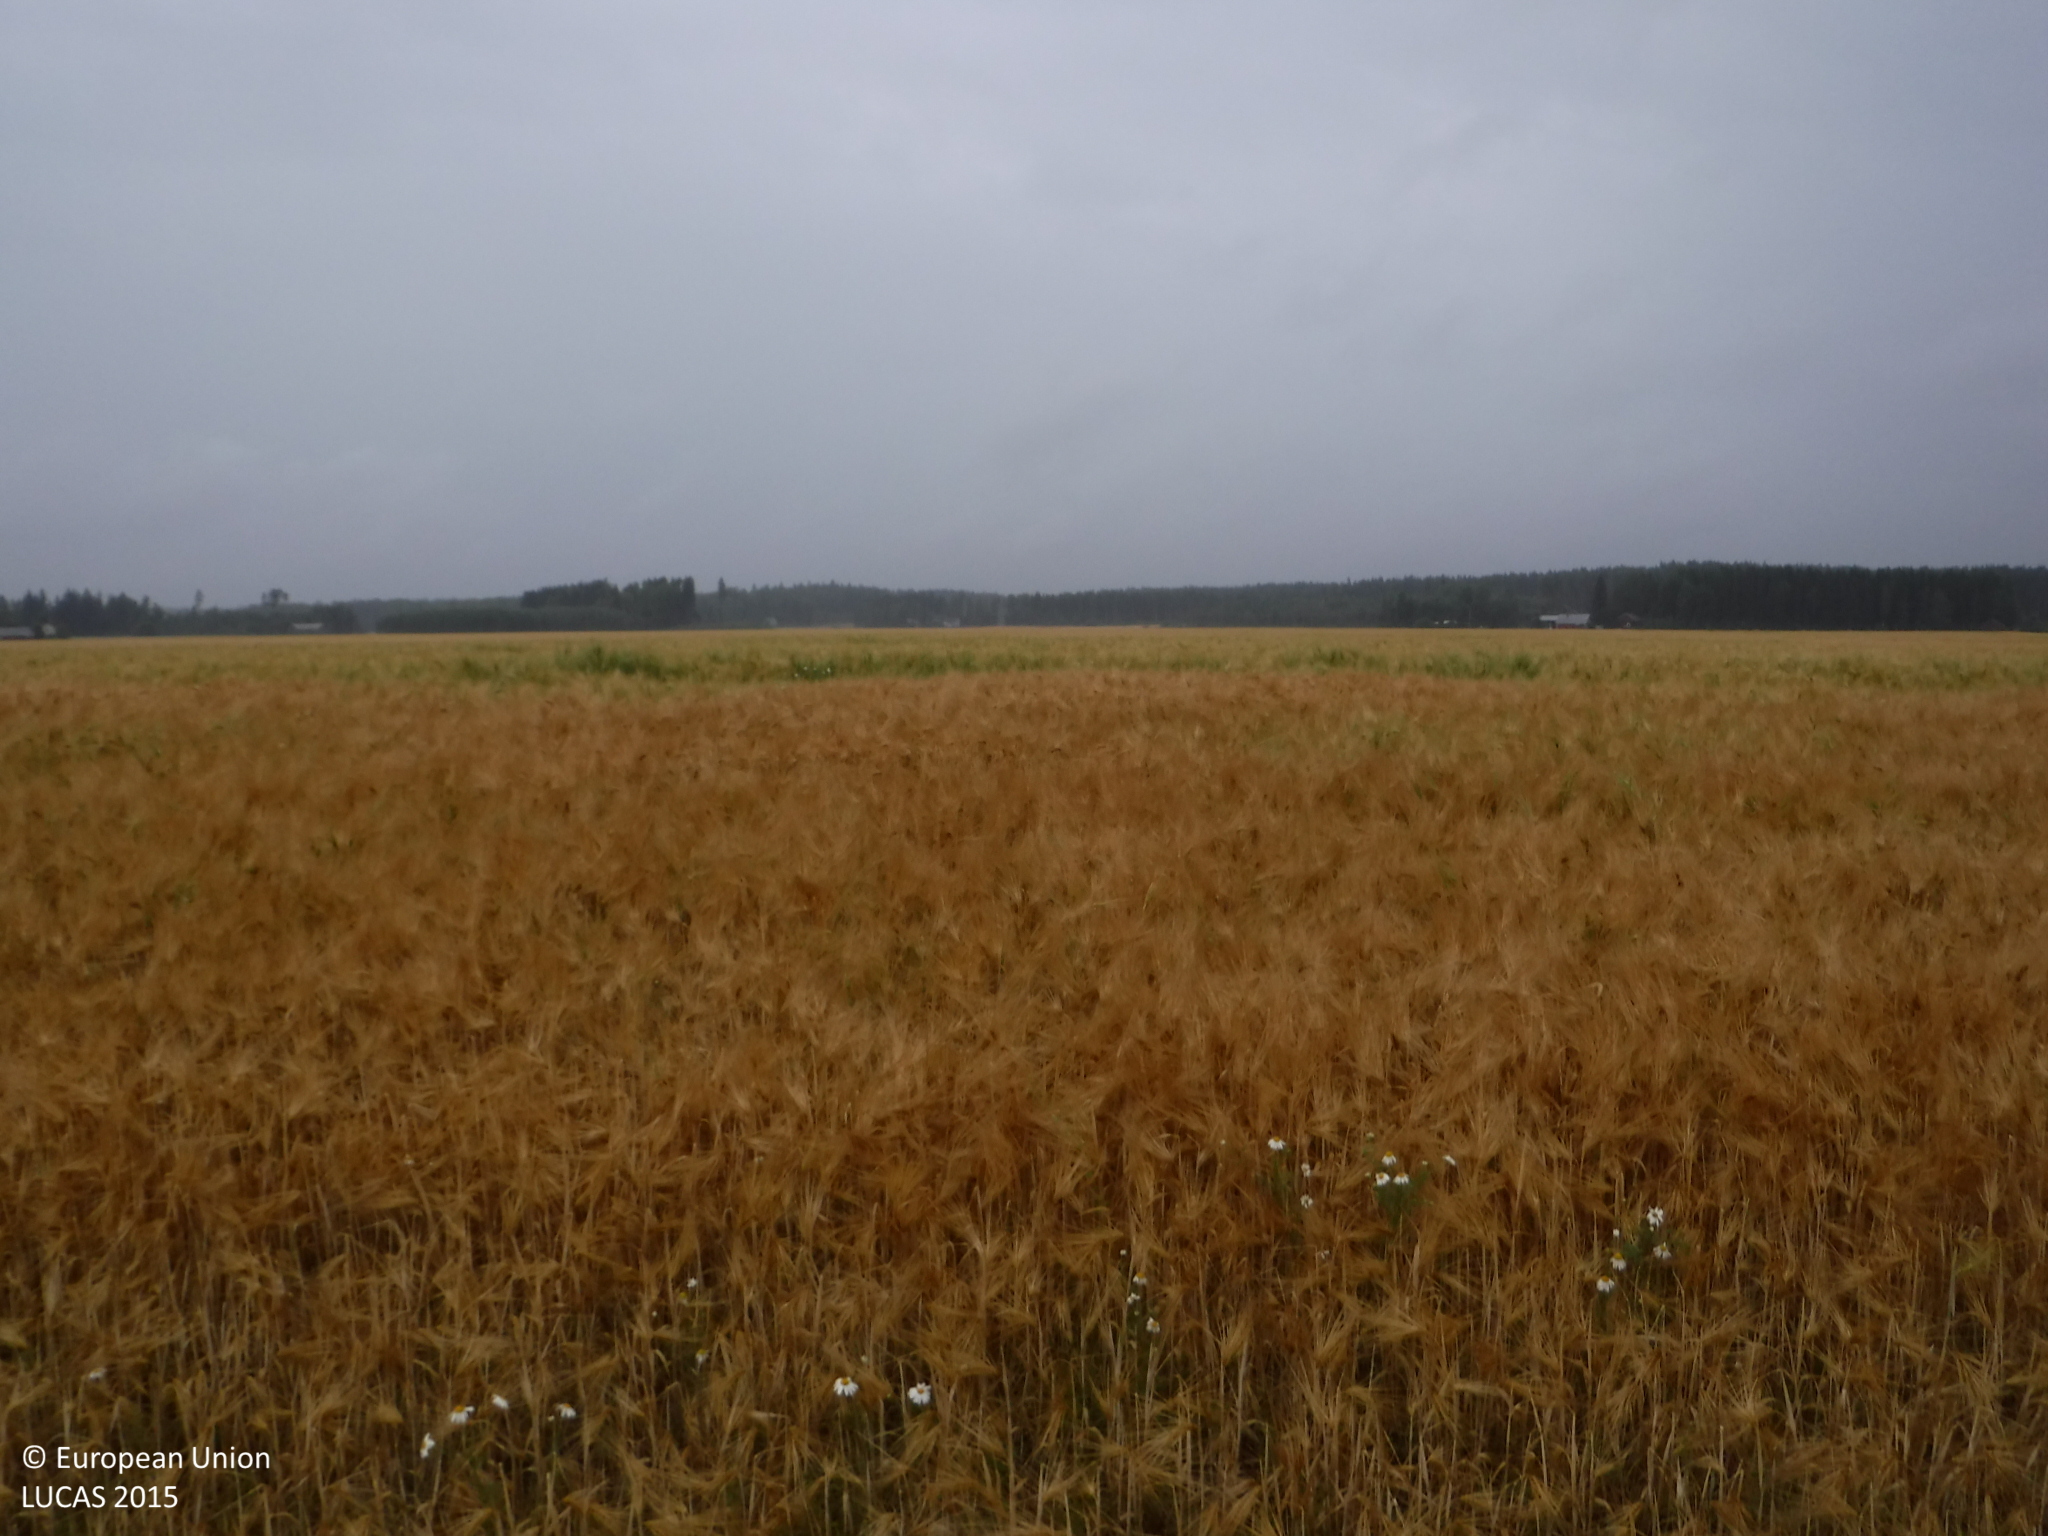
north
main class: Cropland
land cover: Barley
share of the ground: > 75 %
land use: Agriculture (excluding fallow land and kitchen gardens)
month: August
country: FI
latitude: 61.2095
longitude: 22.9340
